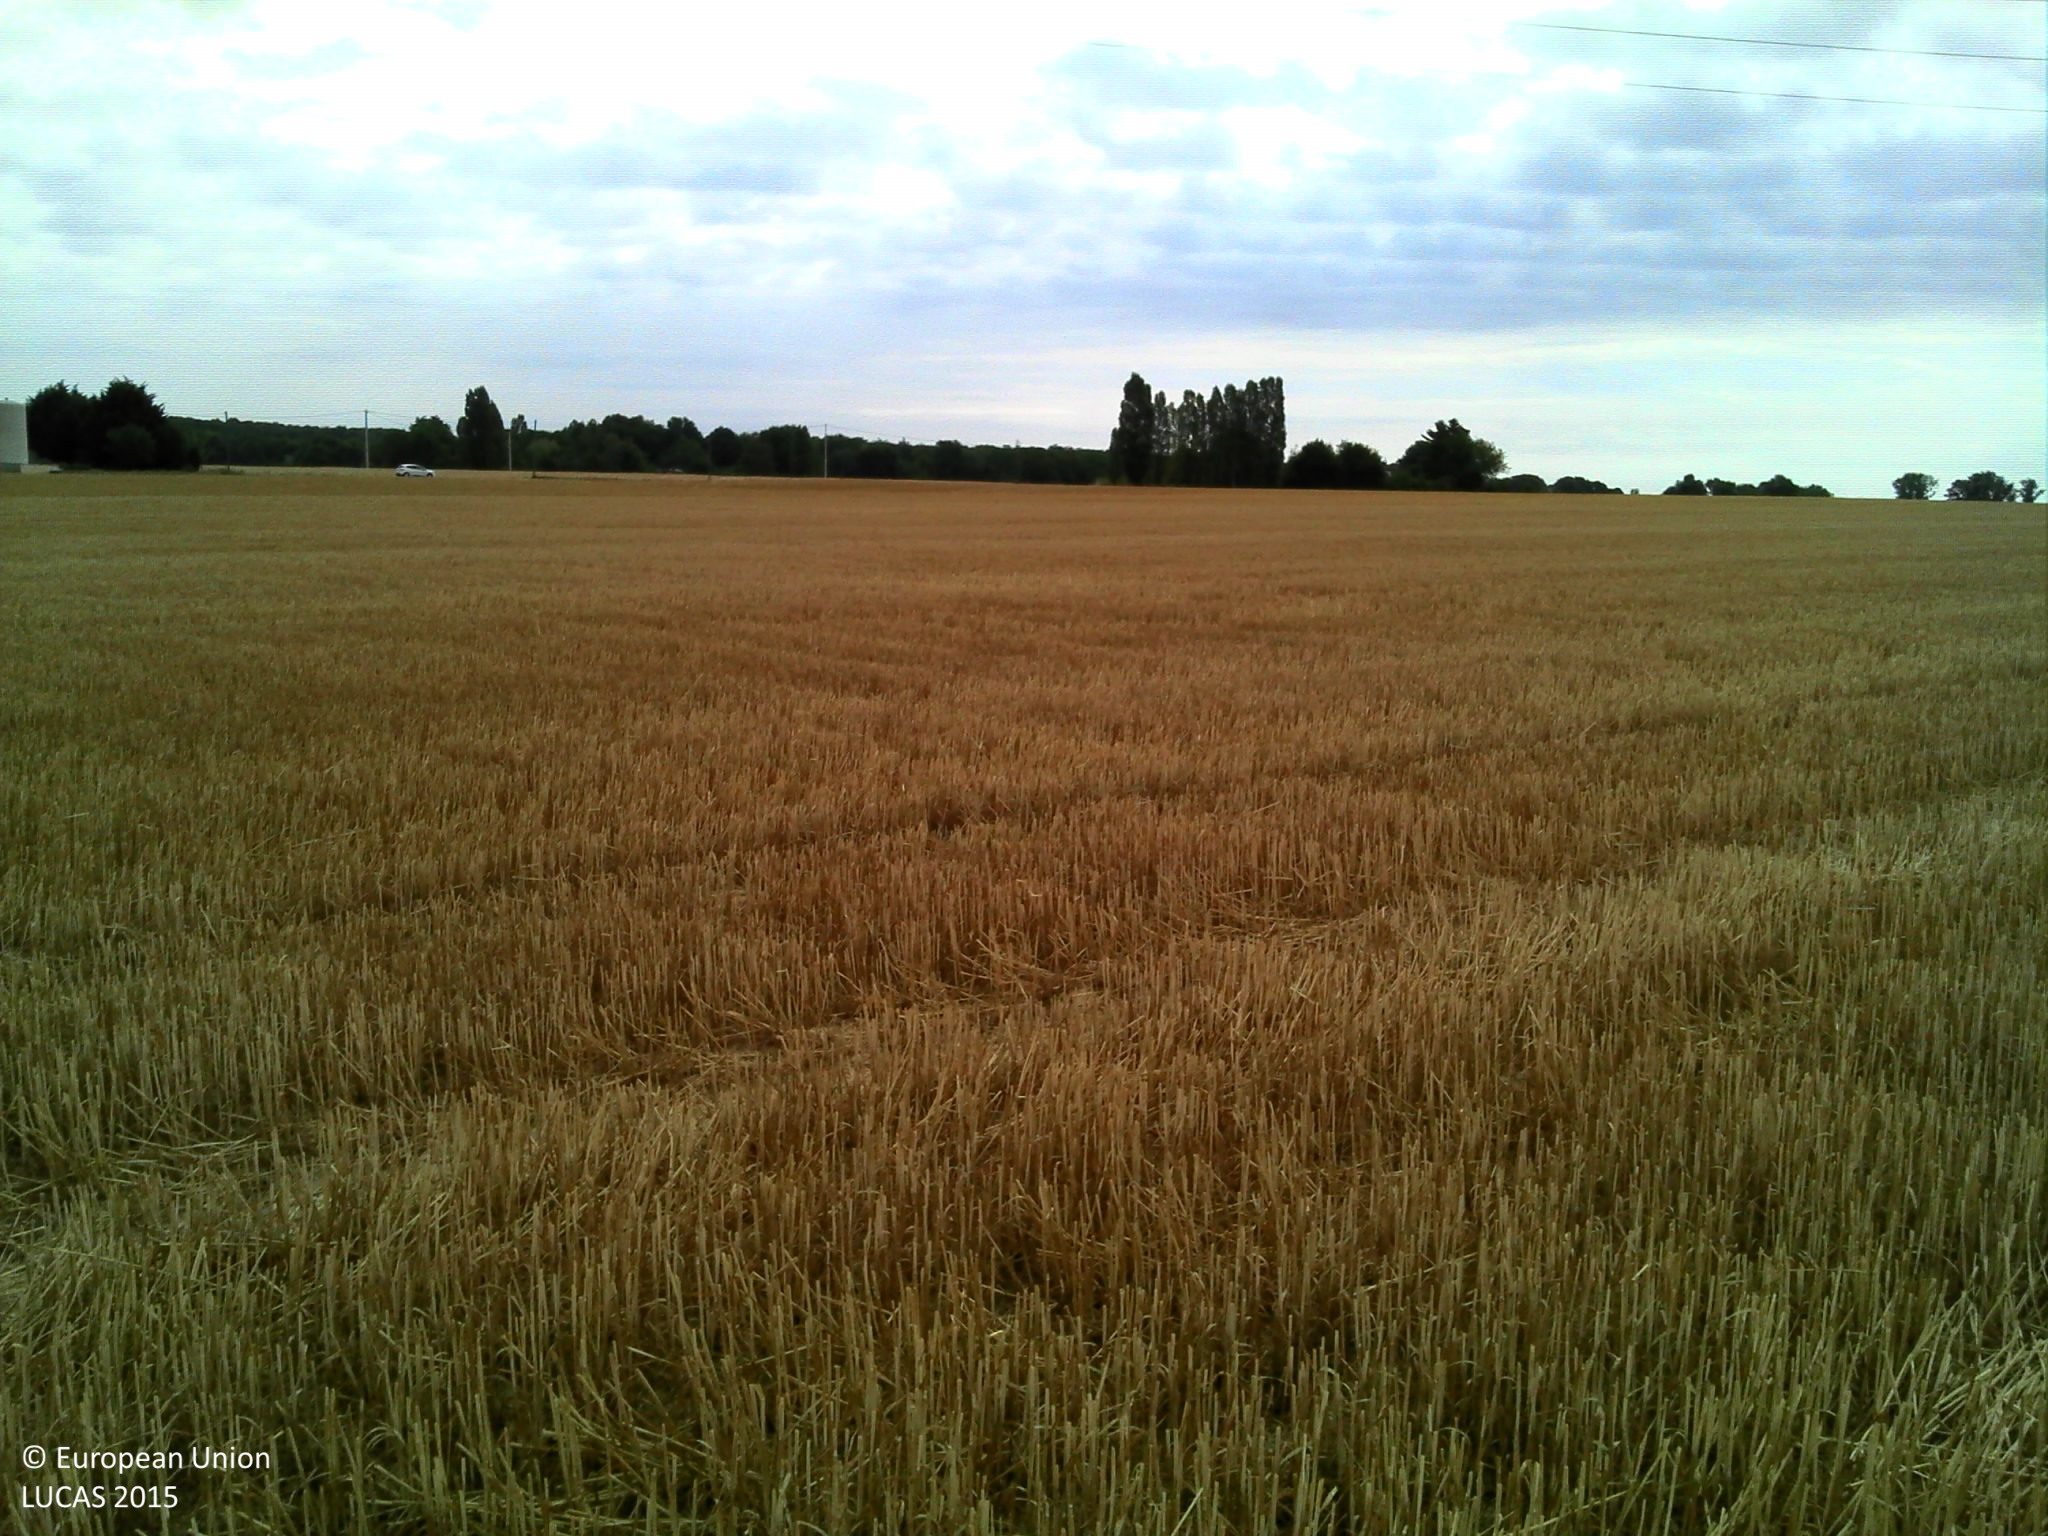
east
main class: Cropland
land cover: Common wheat
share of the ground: > 75 %
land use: Agriculture (excluding fallow land and kitchen gardens)
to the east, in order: Common wheat; Electric lines; Common wheat
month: July
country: FR
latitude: 48.0262
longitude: 3.1144
